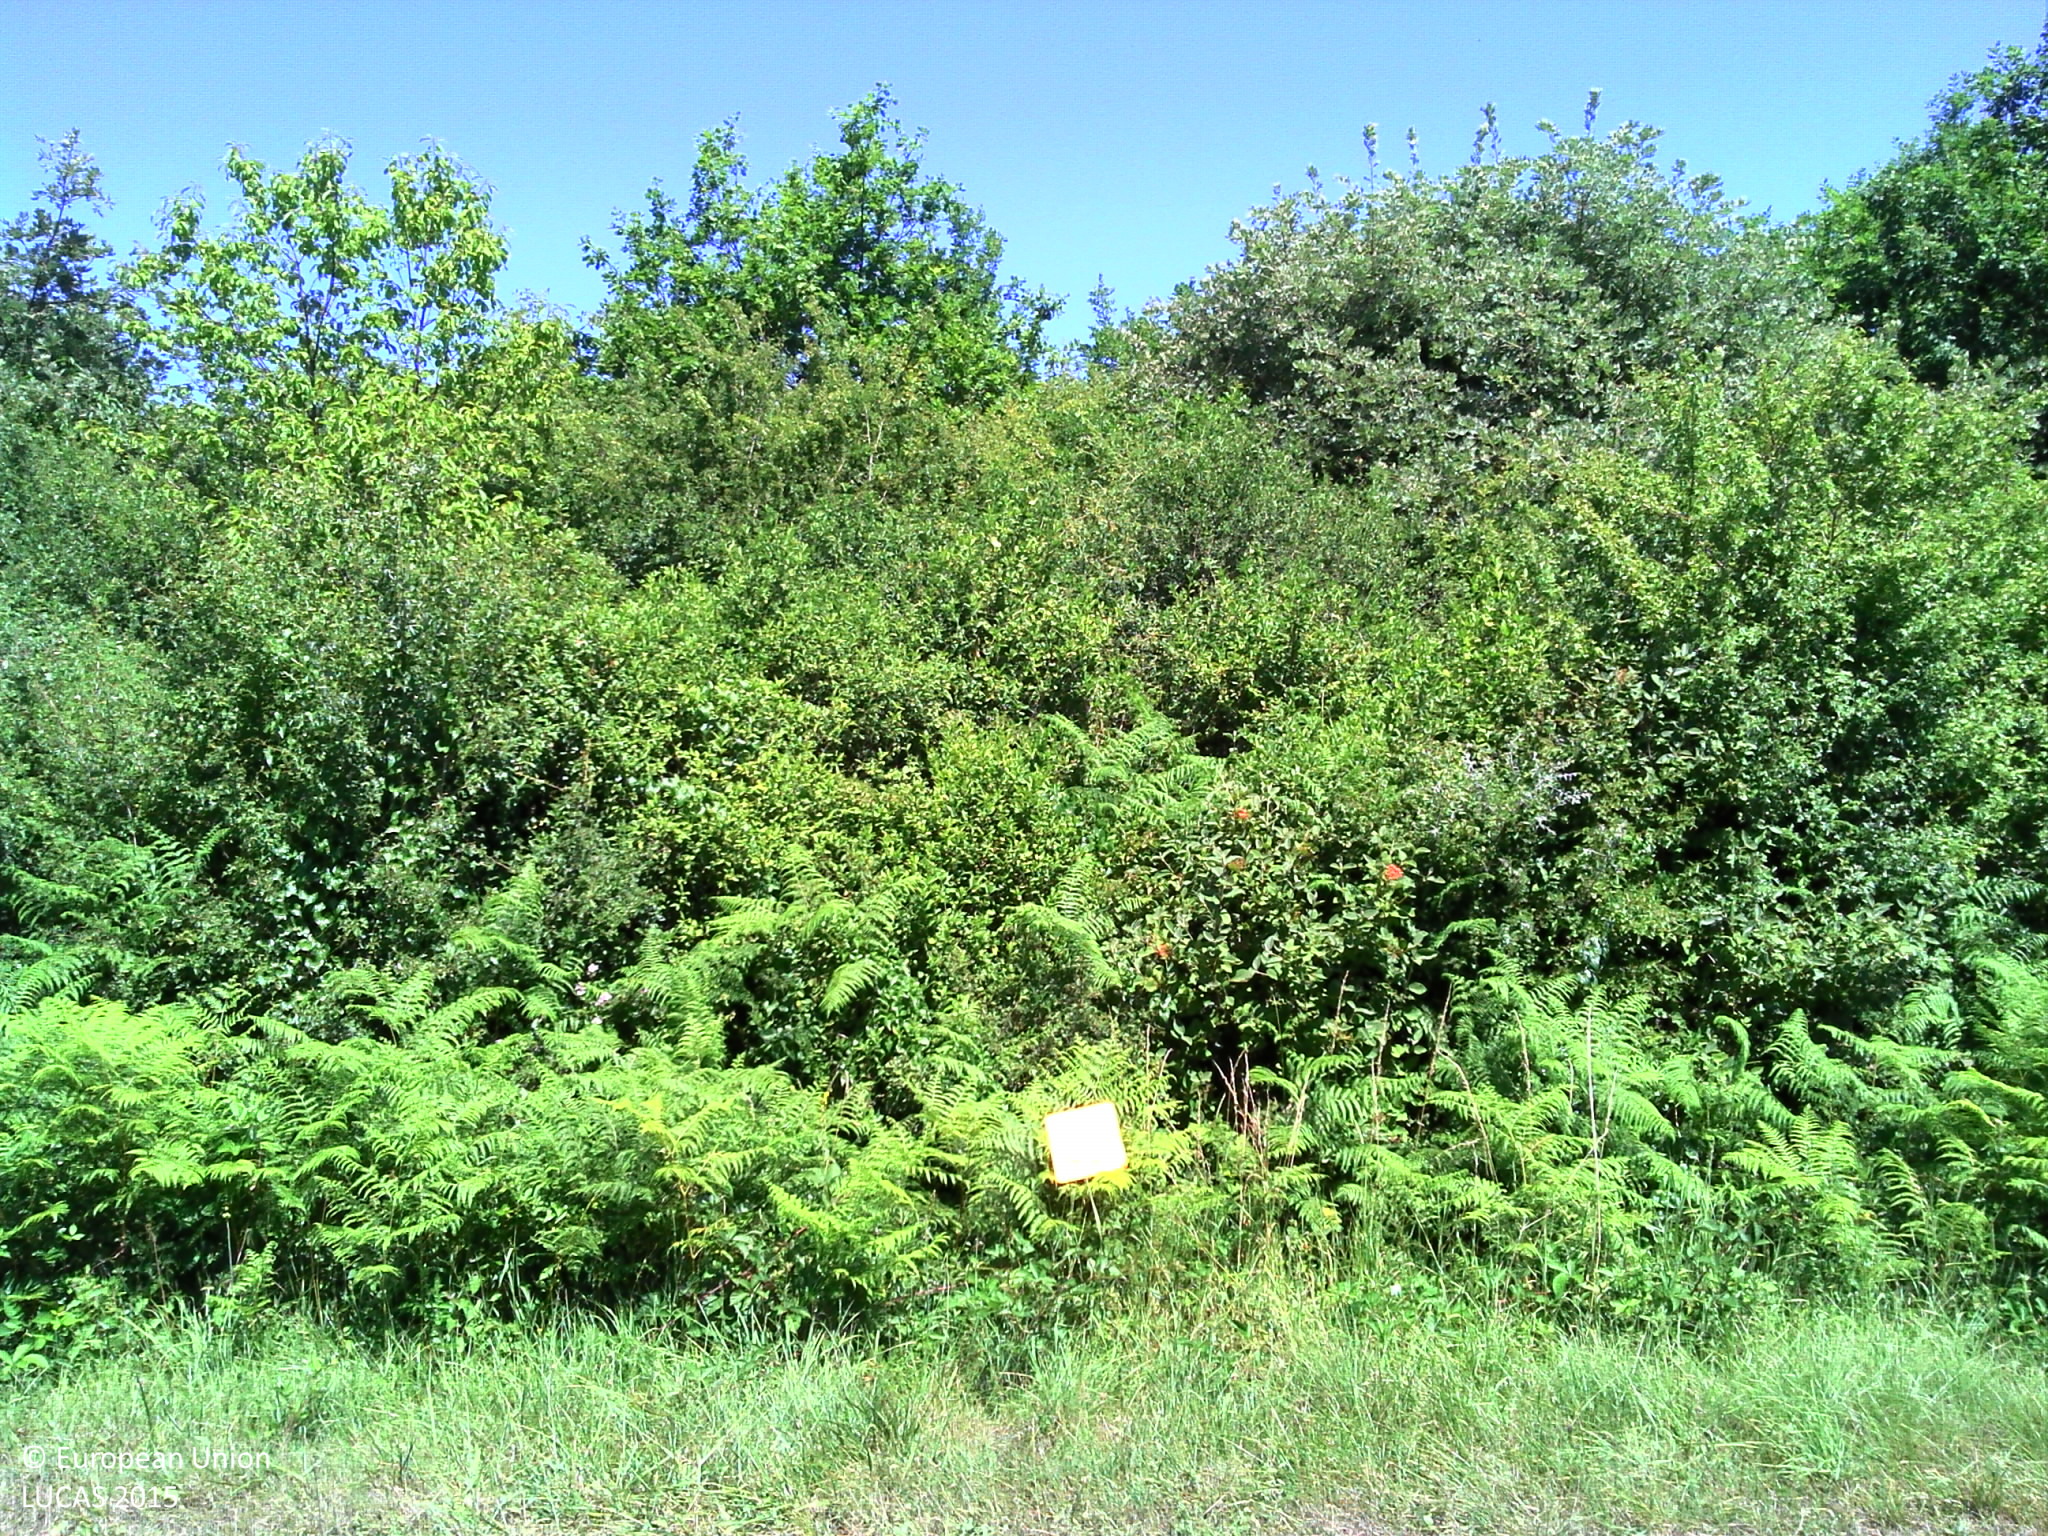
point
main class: Woodland
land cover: Broadleaved woodland
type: thermophilous deciduous forest
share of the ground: > 75 %
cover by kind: broadleaved forest trees 90 %, herbaceous plants 10 %
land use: Forestry
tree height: > 5 m
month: June
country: FR
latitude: 45.5798
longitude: 0.4643
